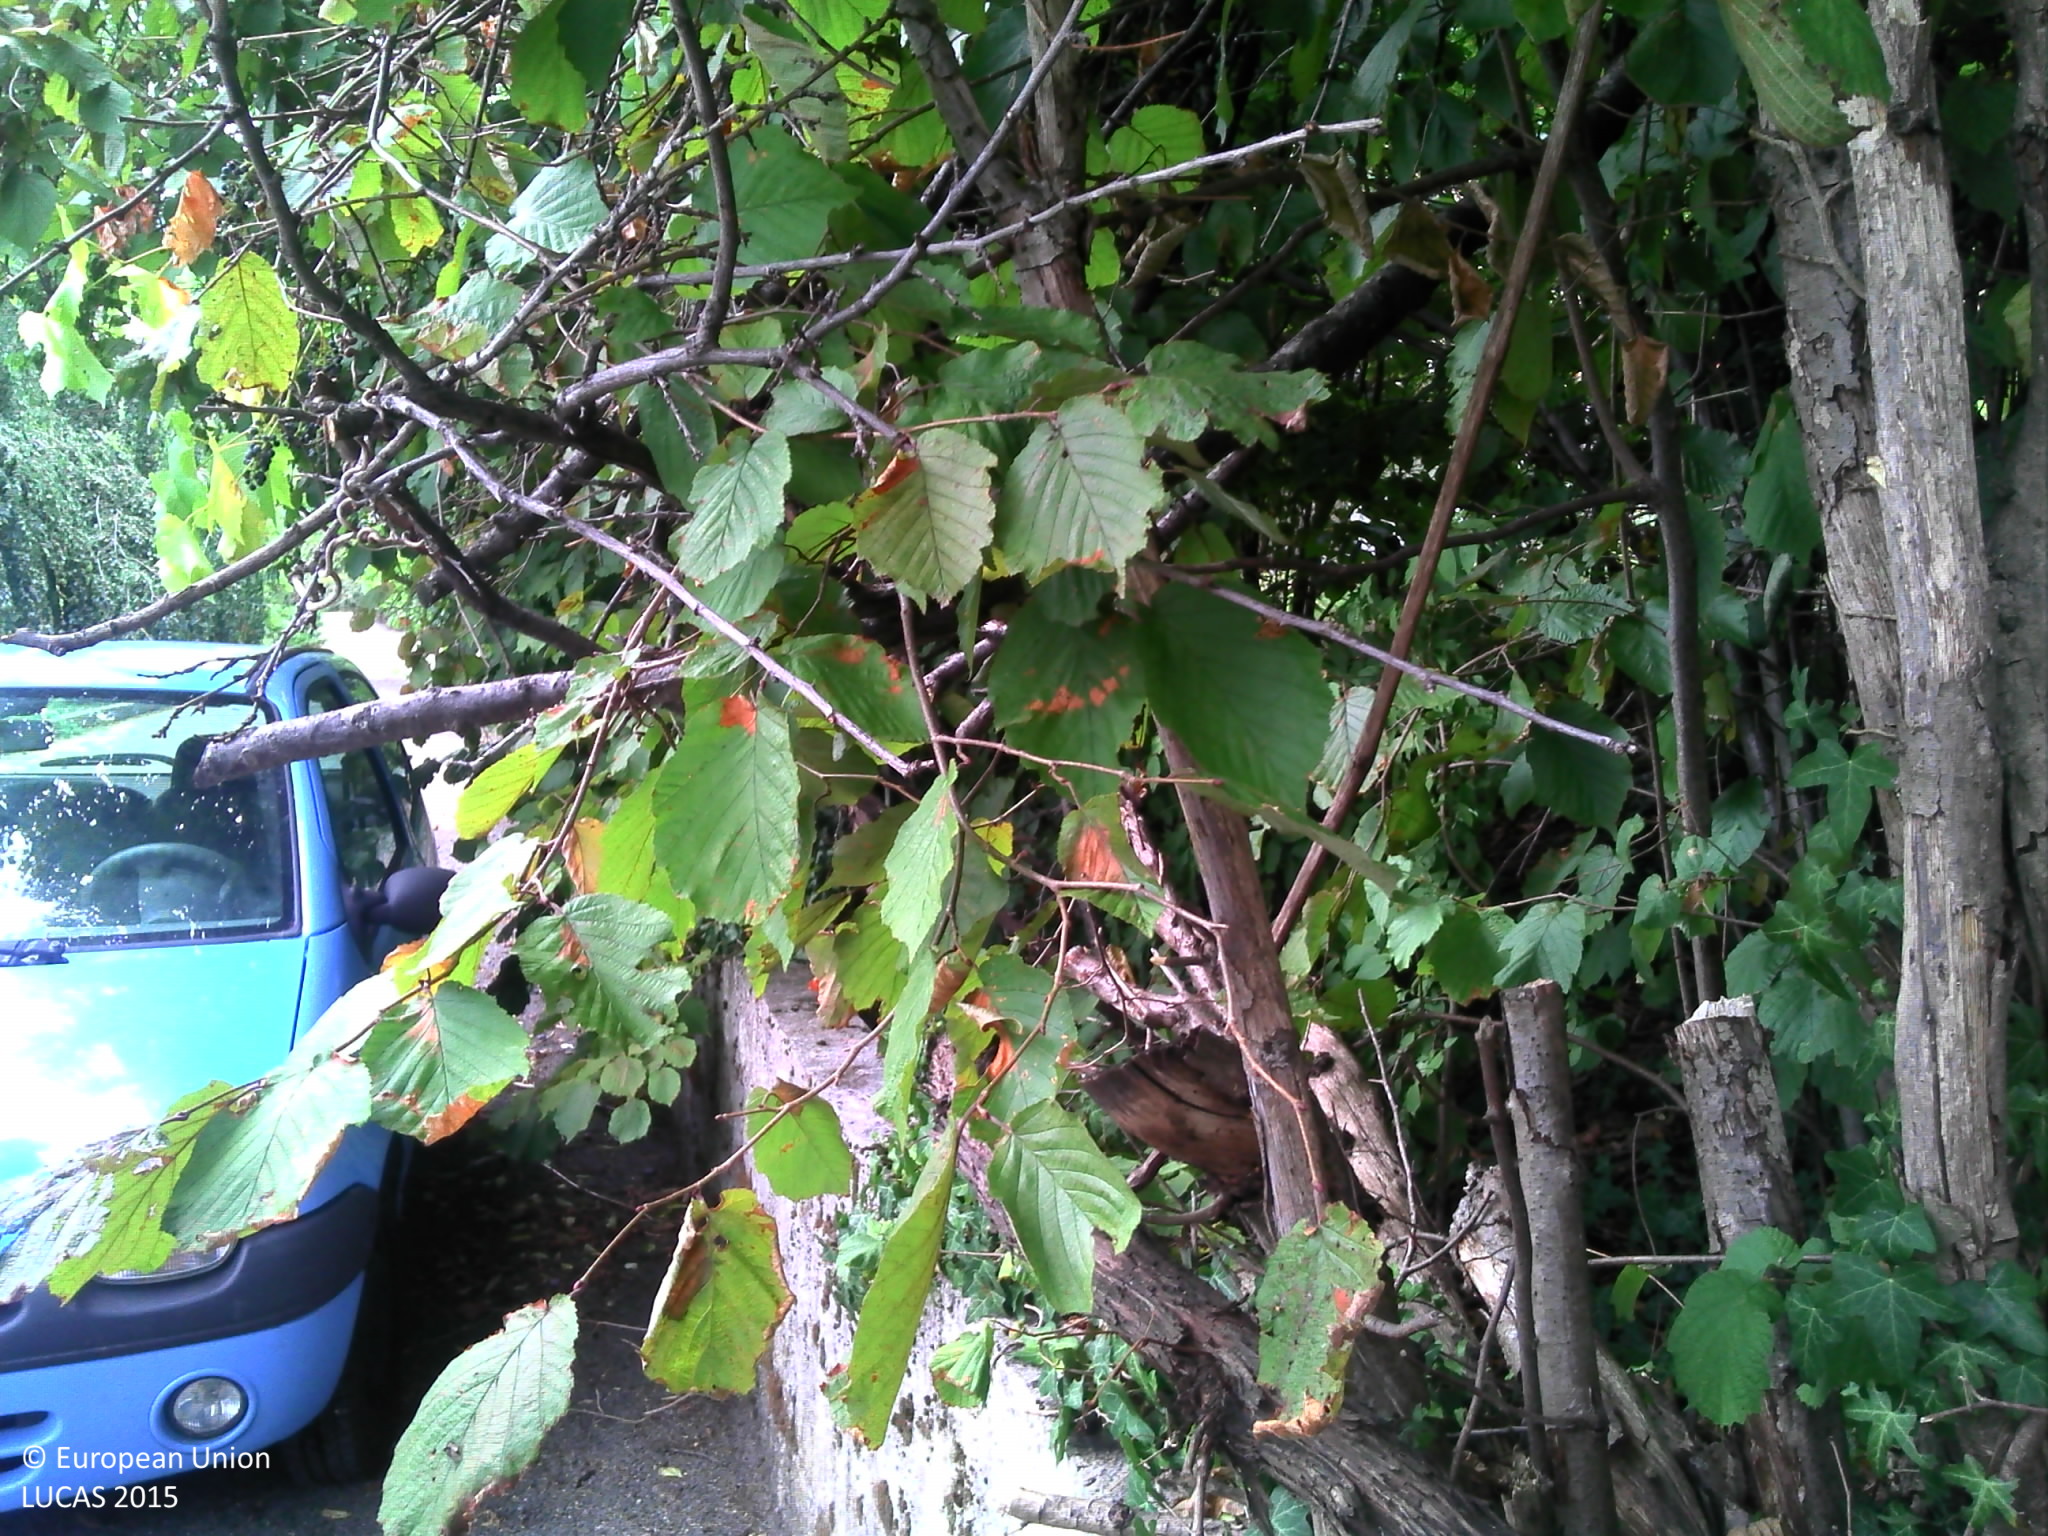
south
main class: Woodland
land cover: Broadleaved woodland
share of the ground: > 75 %
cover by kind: broadleaved forest trees 90 %, herbaceous plants 10 %
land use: Residential
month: August
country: FR
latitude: 44.8772
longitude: 4.5750
